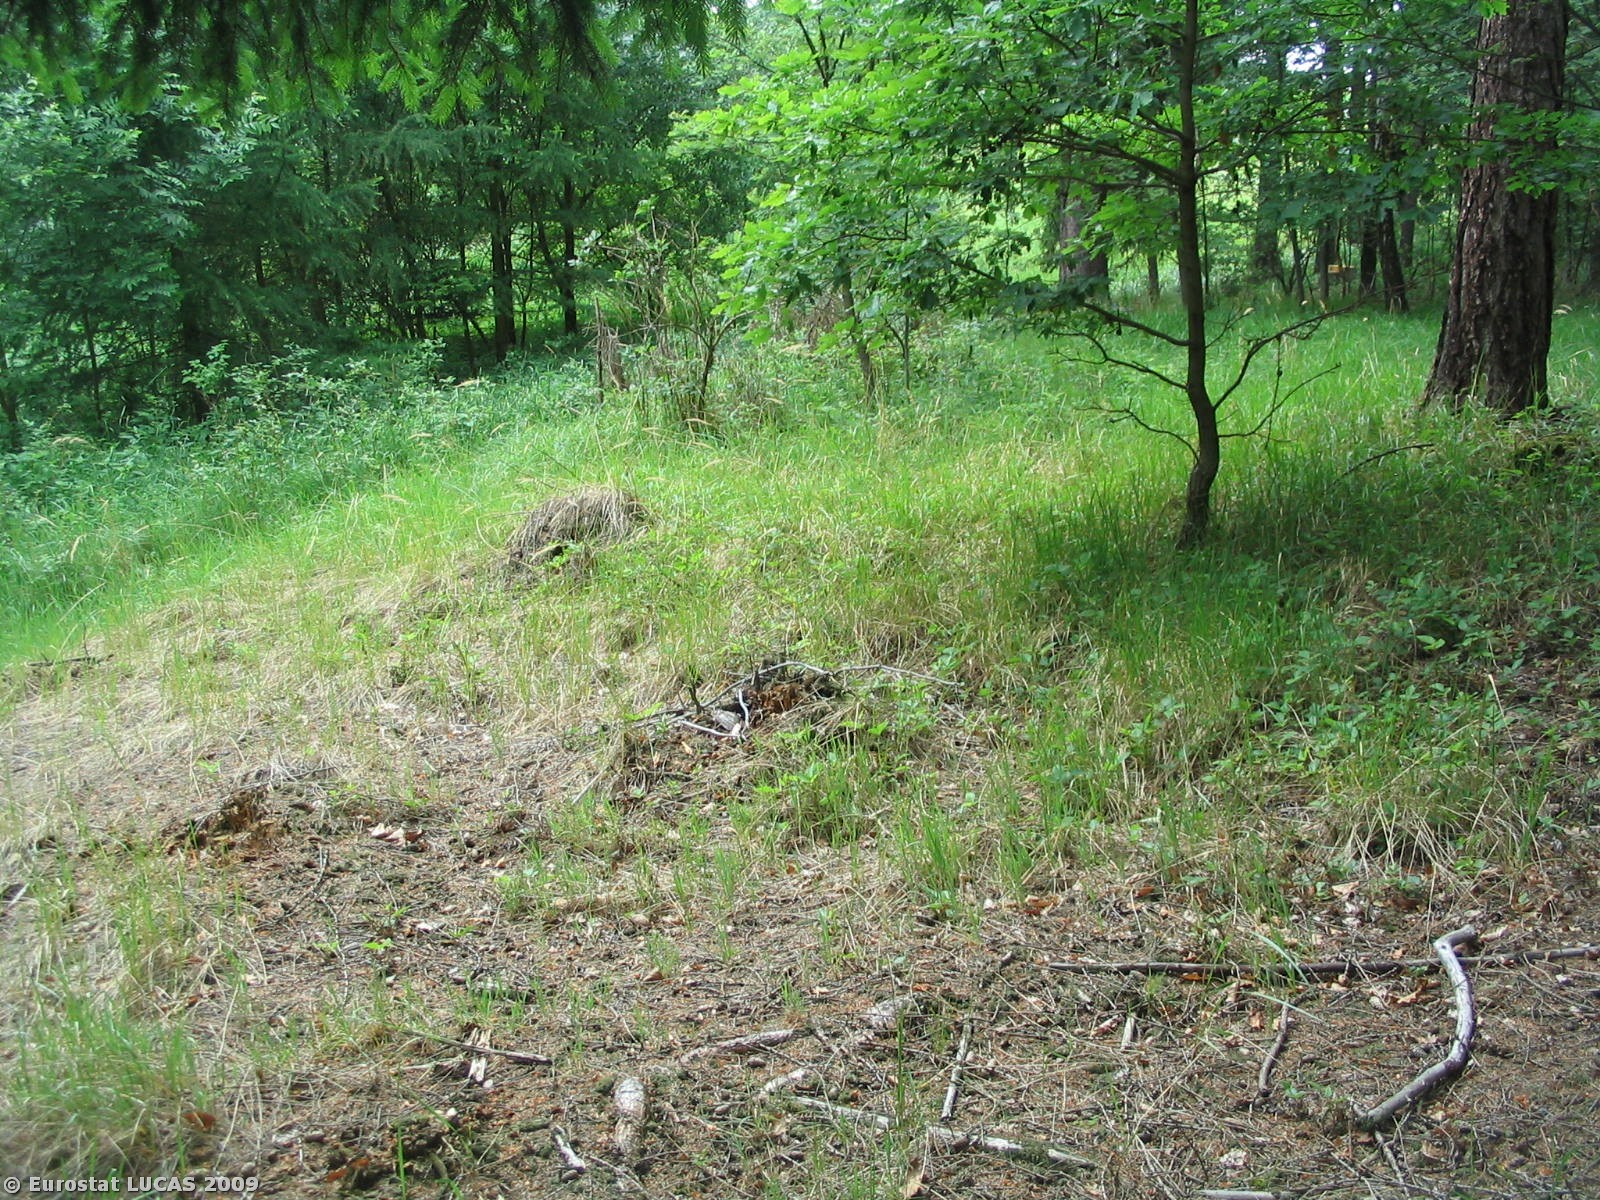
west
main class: Woodland
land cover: Coniferous woodland
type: hemiboreal forest and nemoral coniferous forest and mixed broadleaved-coniferous forest
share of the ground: > 75 %
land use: Forestry
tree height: > 5 m
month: May
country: CZ
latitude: 49.4409
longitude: 16.4752
